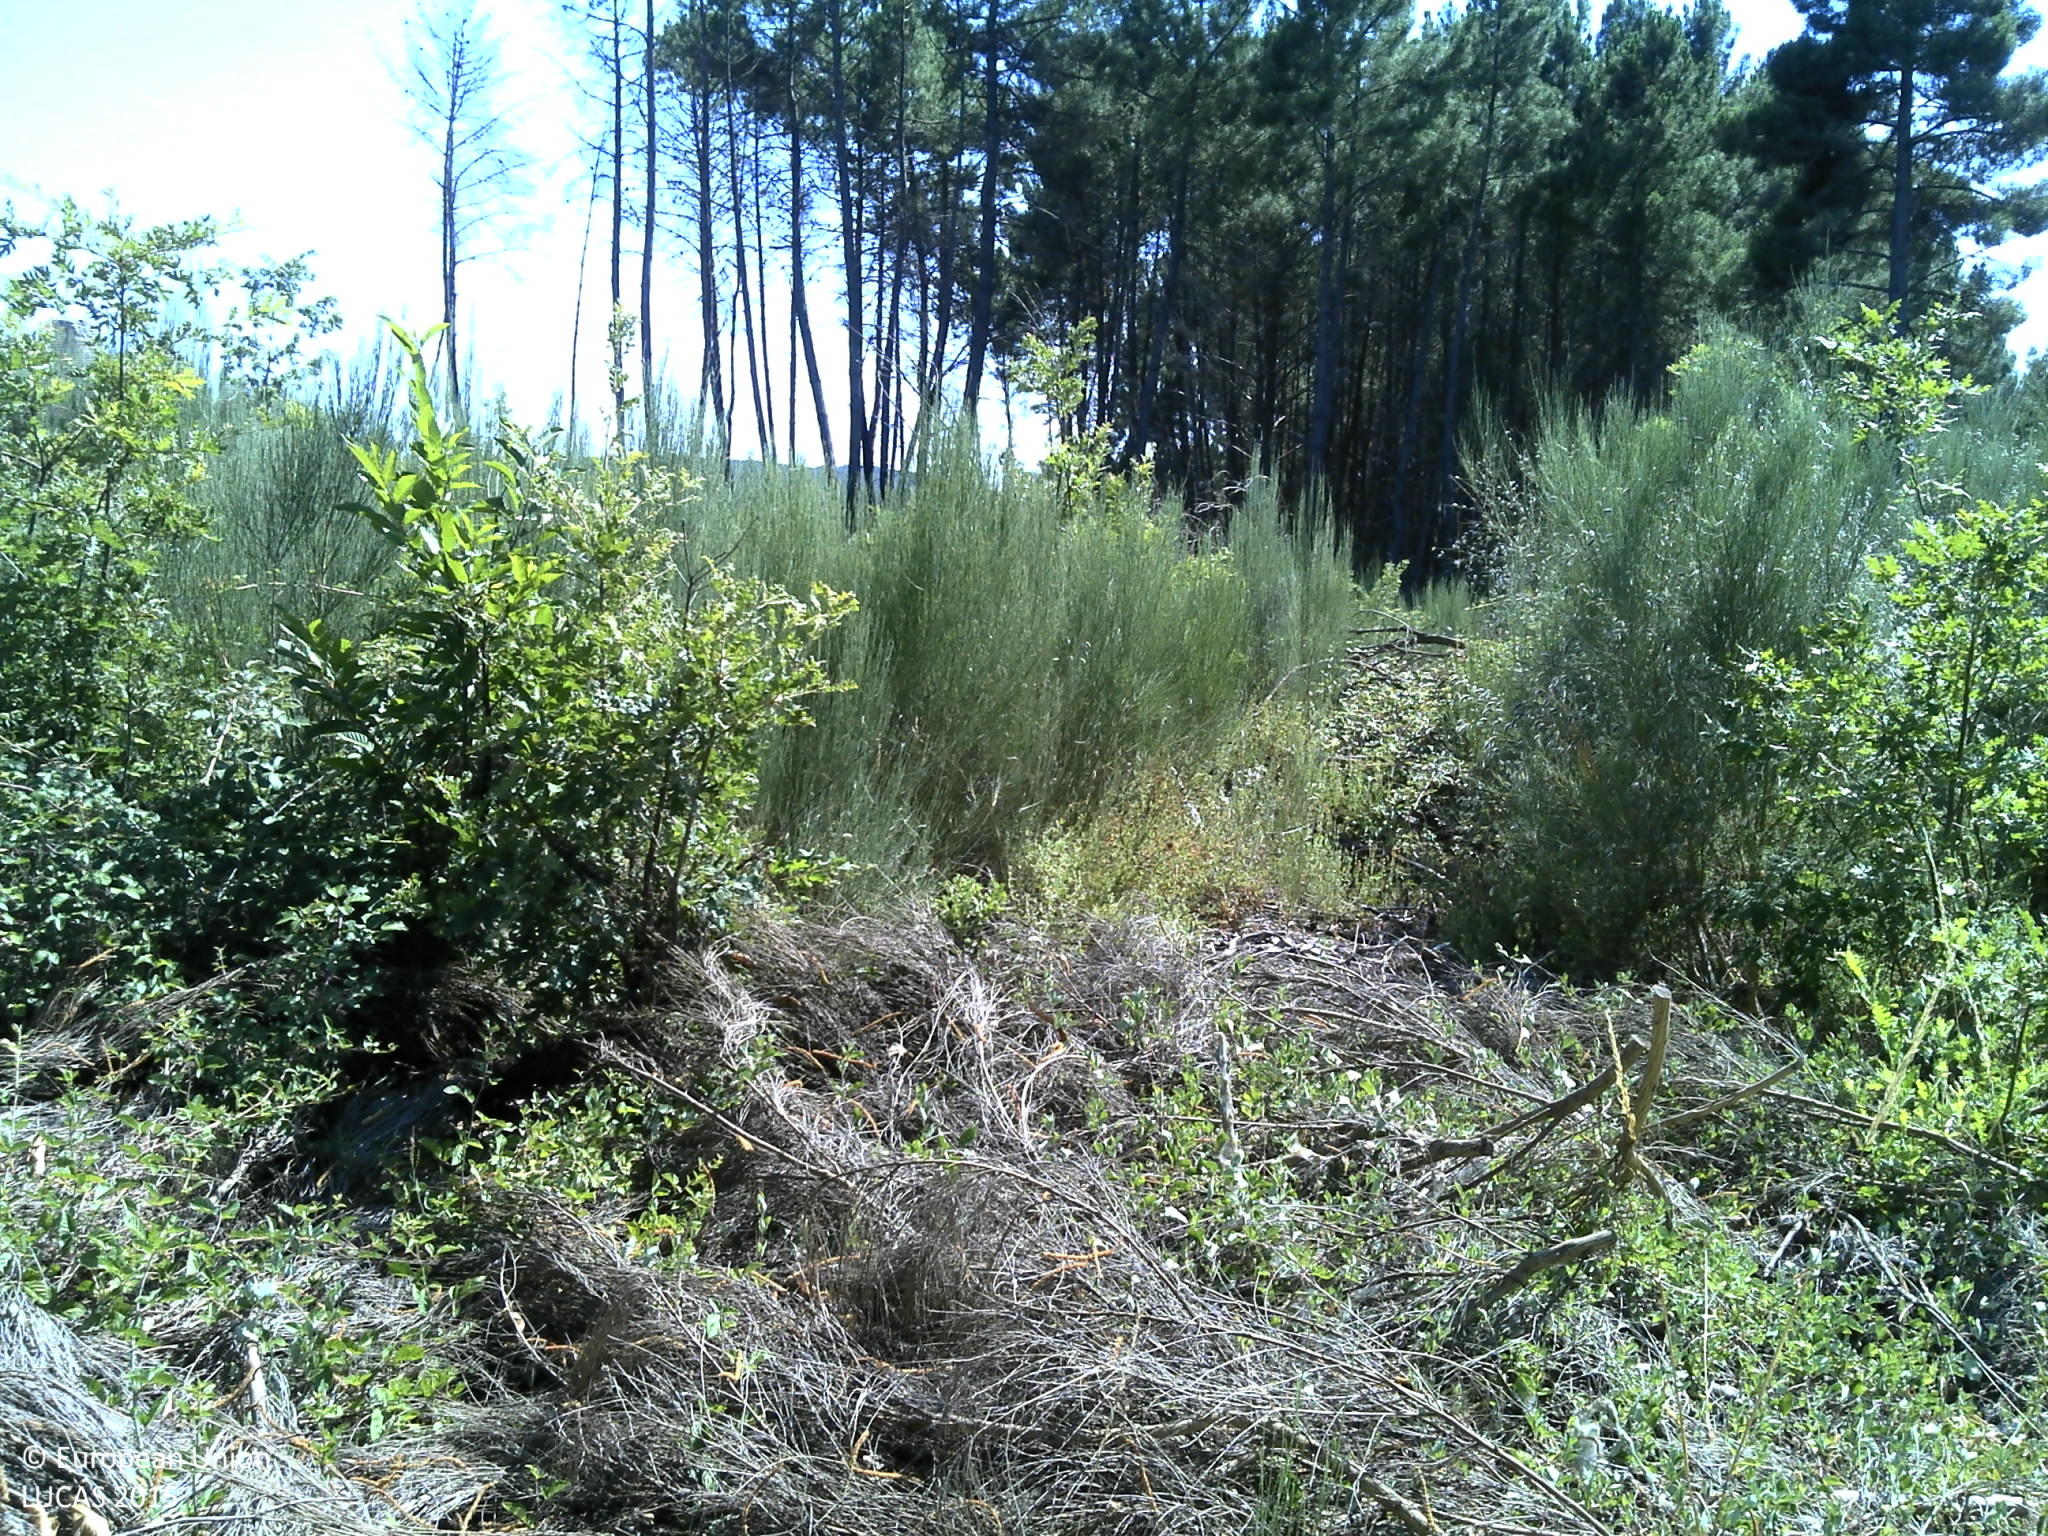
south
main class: Cropland
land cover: Nuts trees
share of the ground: < 10 %
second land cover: Shrubland without tree cover
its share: 25 - 50 %
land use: Agriculture (excluding fallow land and kitchen gardens)
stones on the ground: 25 - 50 %
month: July
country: PT
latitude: 40.8589
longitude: -7.4965
